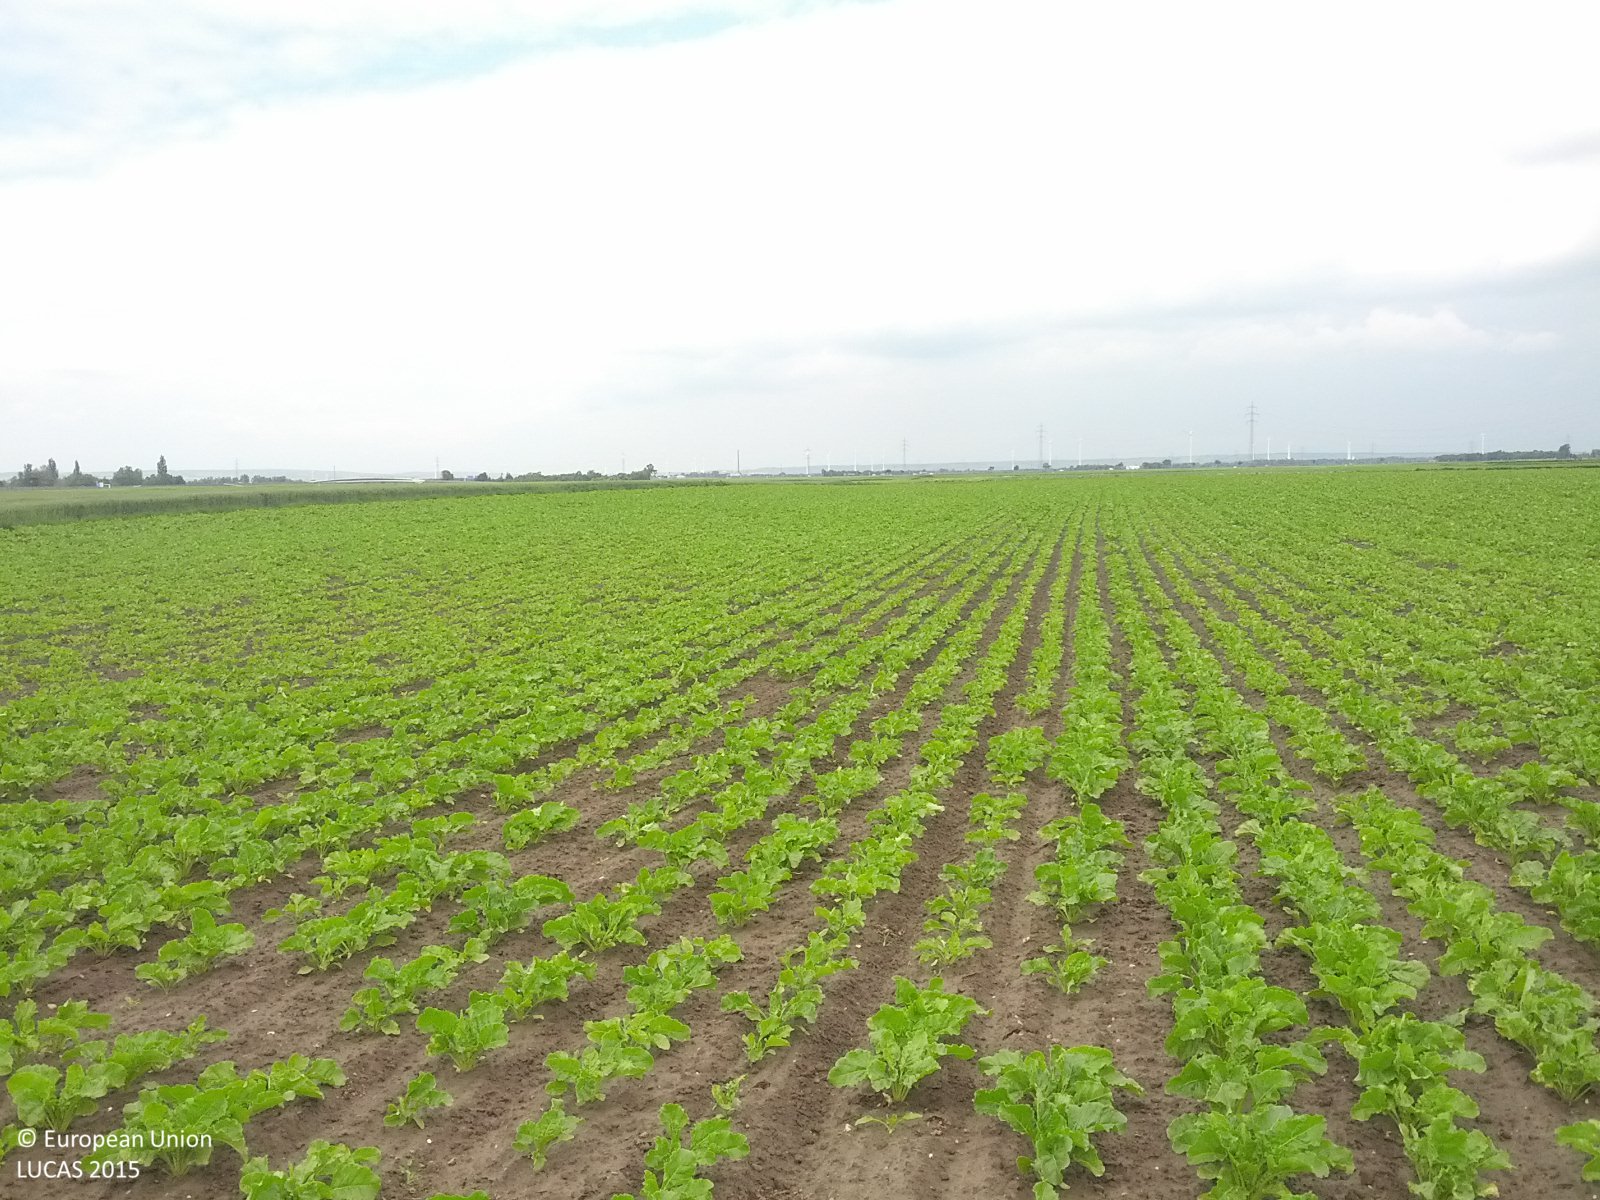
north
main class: Cropland
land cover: Sugar beet
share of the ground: 50 - 75 %
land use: Agriculture (excluding fallow land and kitchen gardens)
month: May
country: AT
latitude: 48.2656
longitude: 16.5125
